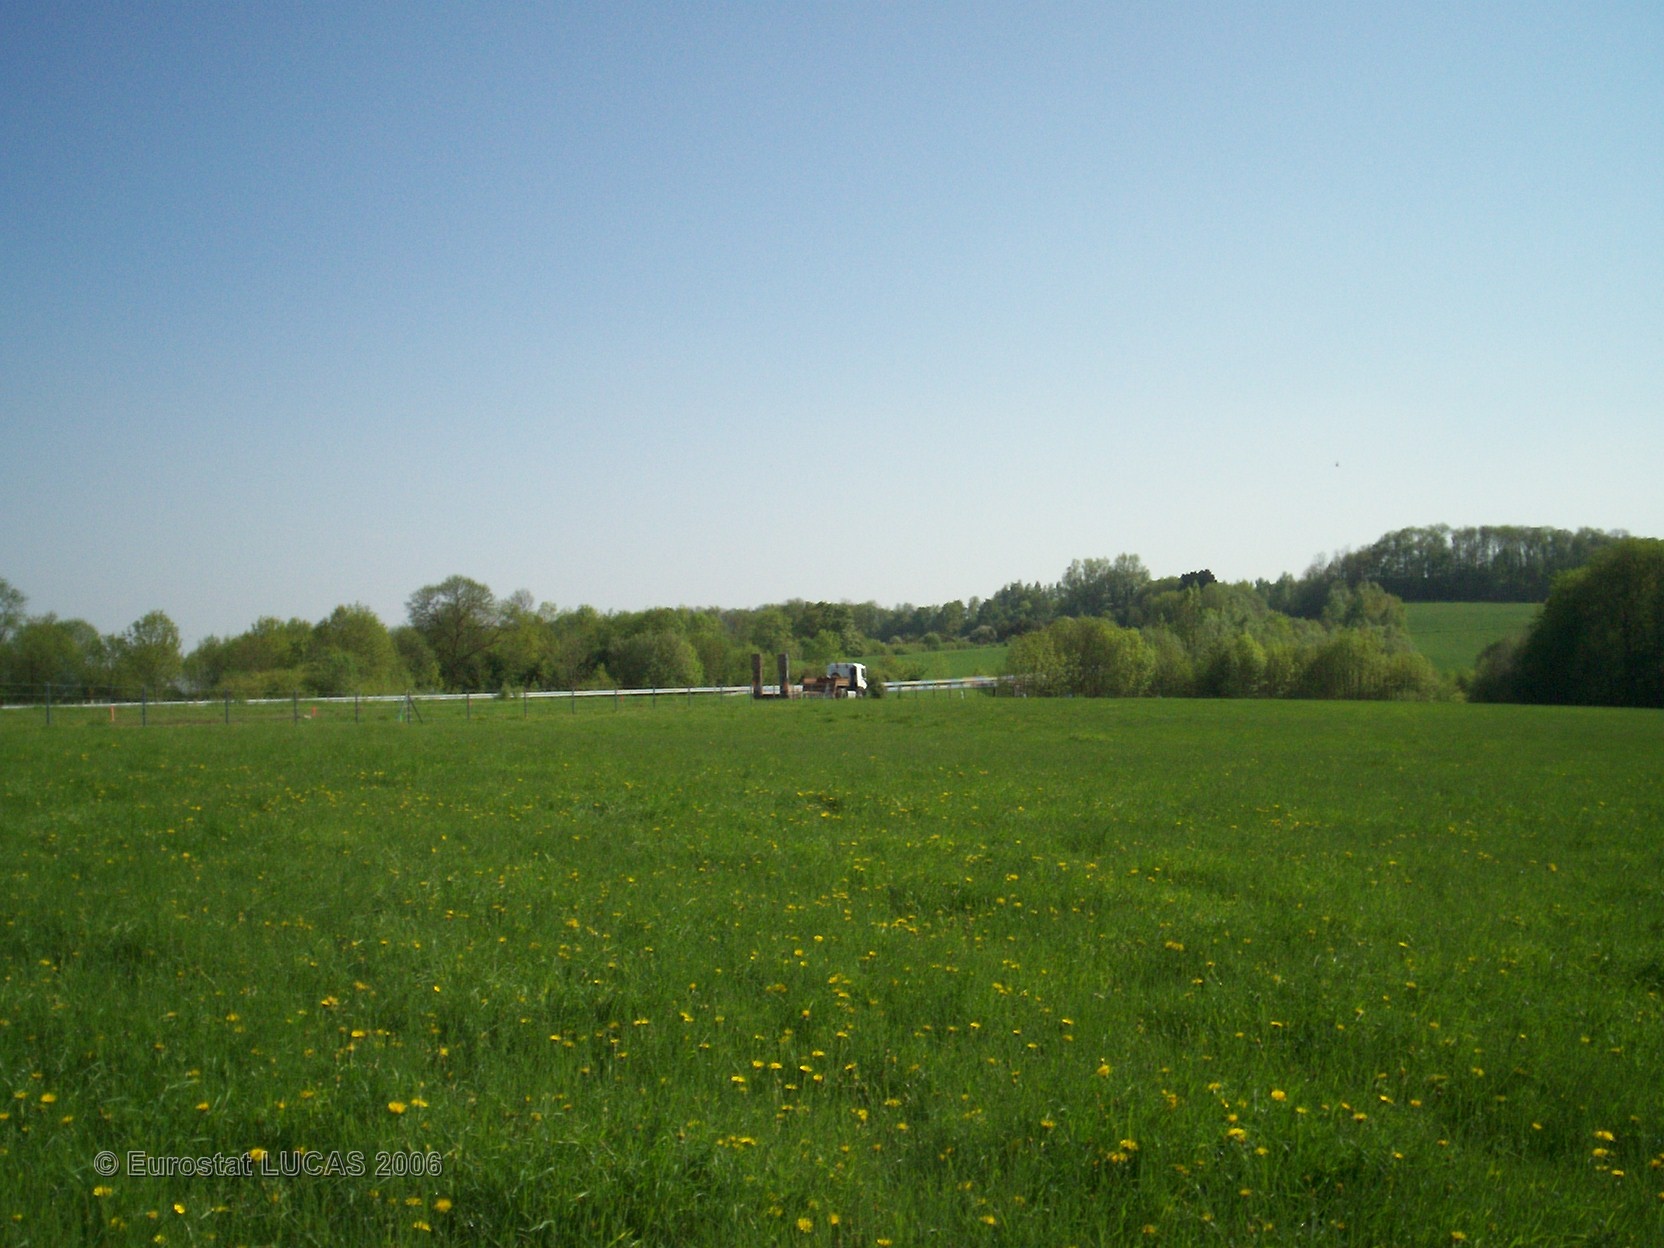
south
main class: Grassland
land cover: Grassland without tree/shrub cover
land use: Agriculture (excluding fallow land and kitchen gardens)
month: May
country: FR
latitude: 49.7330
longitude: 5.0166
